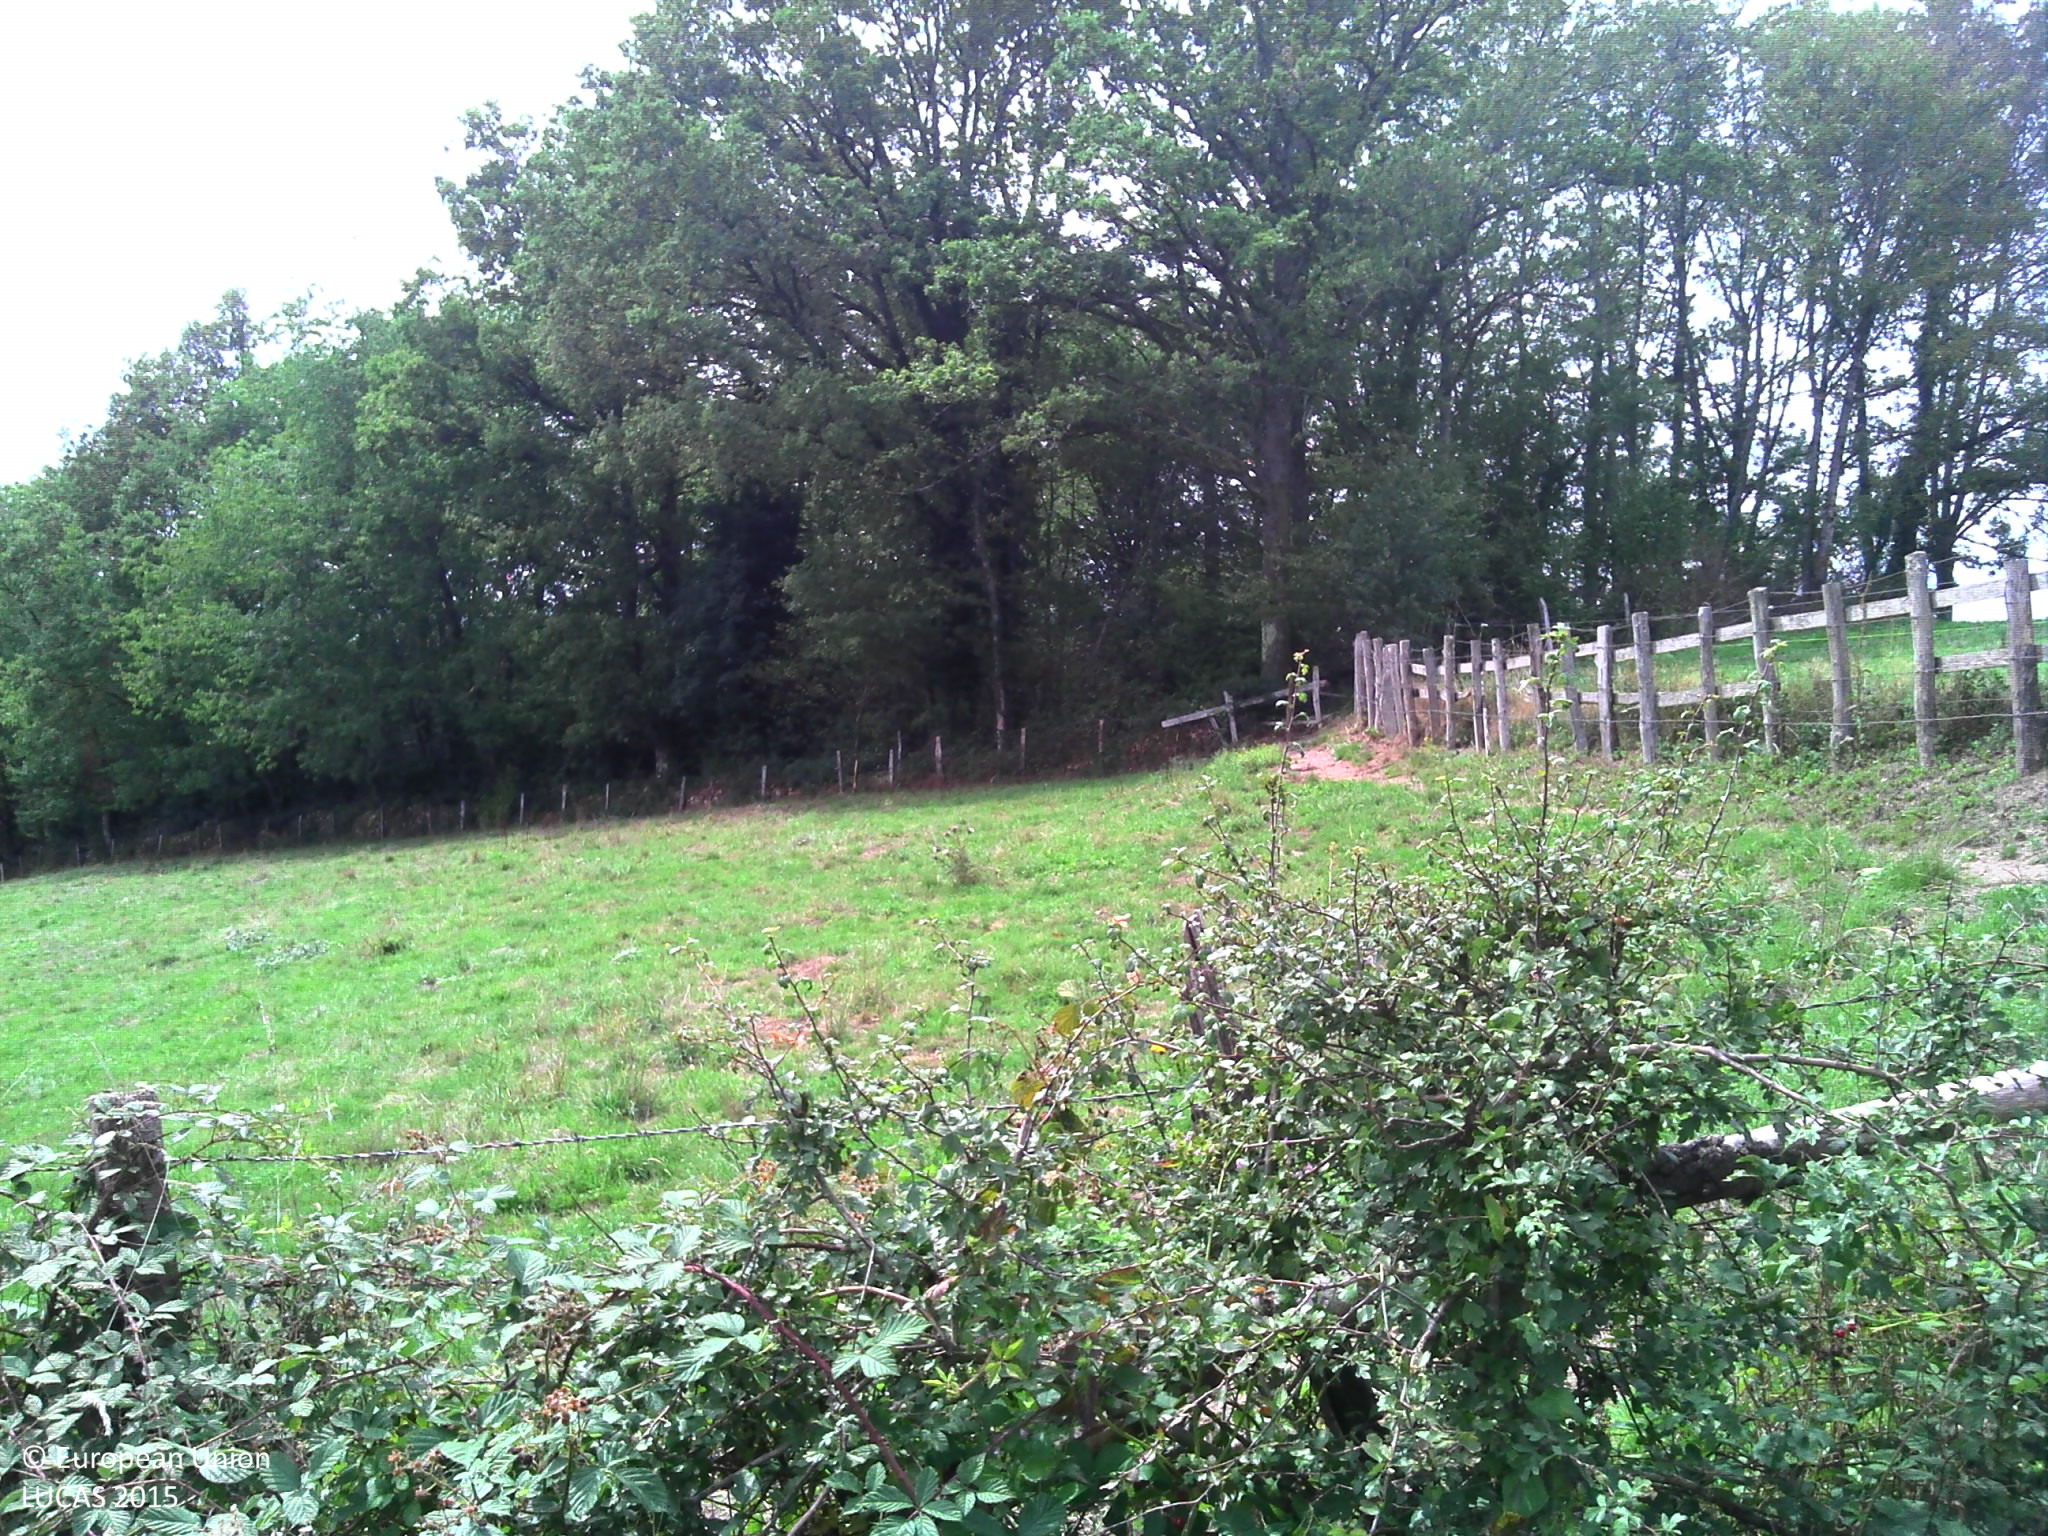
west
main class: Shrubland
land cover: Shrubland without tree cover
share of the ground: > 75 %
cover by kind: shrubs 60 %, herbaceous plants 30 %, consolidated bare surface 10 %
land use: Forestry
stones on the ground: 25 - 50 %
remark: Clear cut
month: August
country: FR
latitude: 46.2413
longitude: 4.4122
